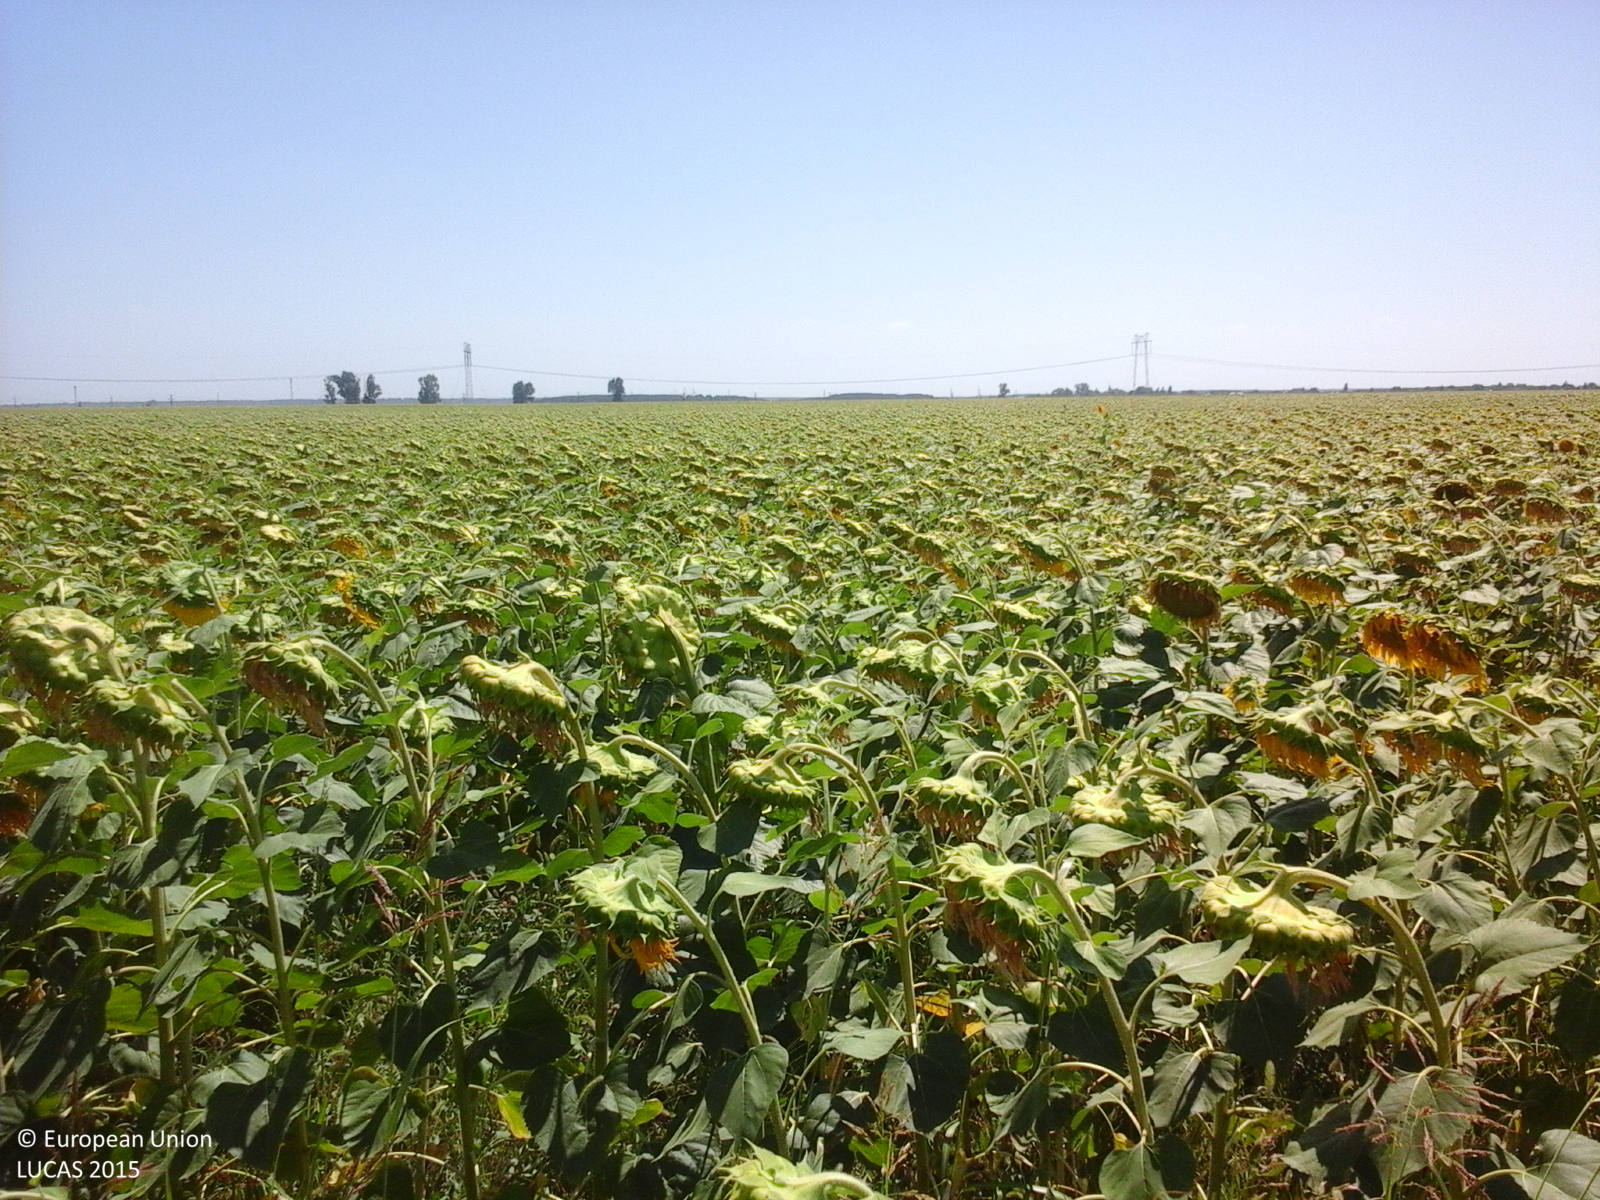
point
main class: Cropland
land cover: Sunflower
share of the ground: > 75 %
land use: Agriculture (excluding fallow land and kitchen gardens)
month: July
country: RO
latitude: 44.2530
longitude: 26.4817
